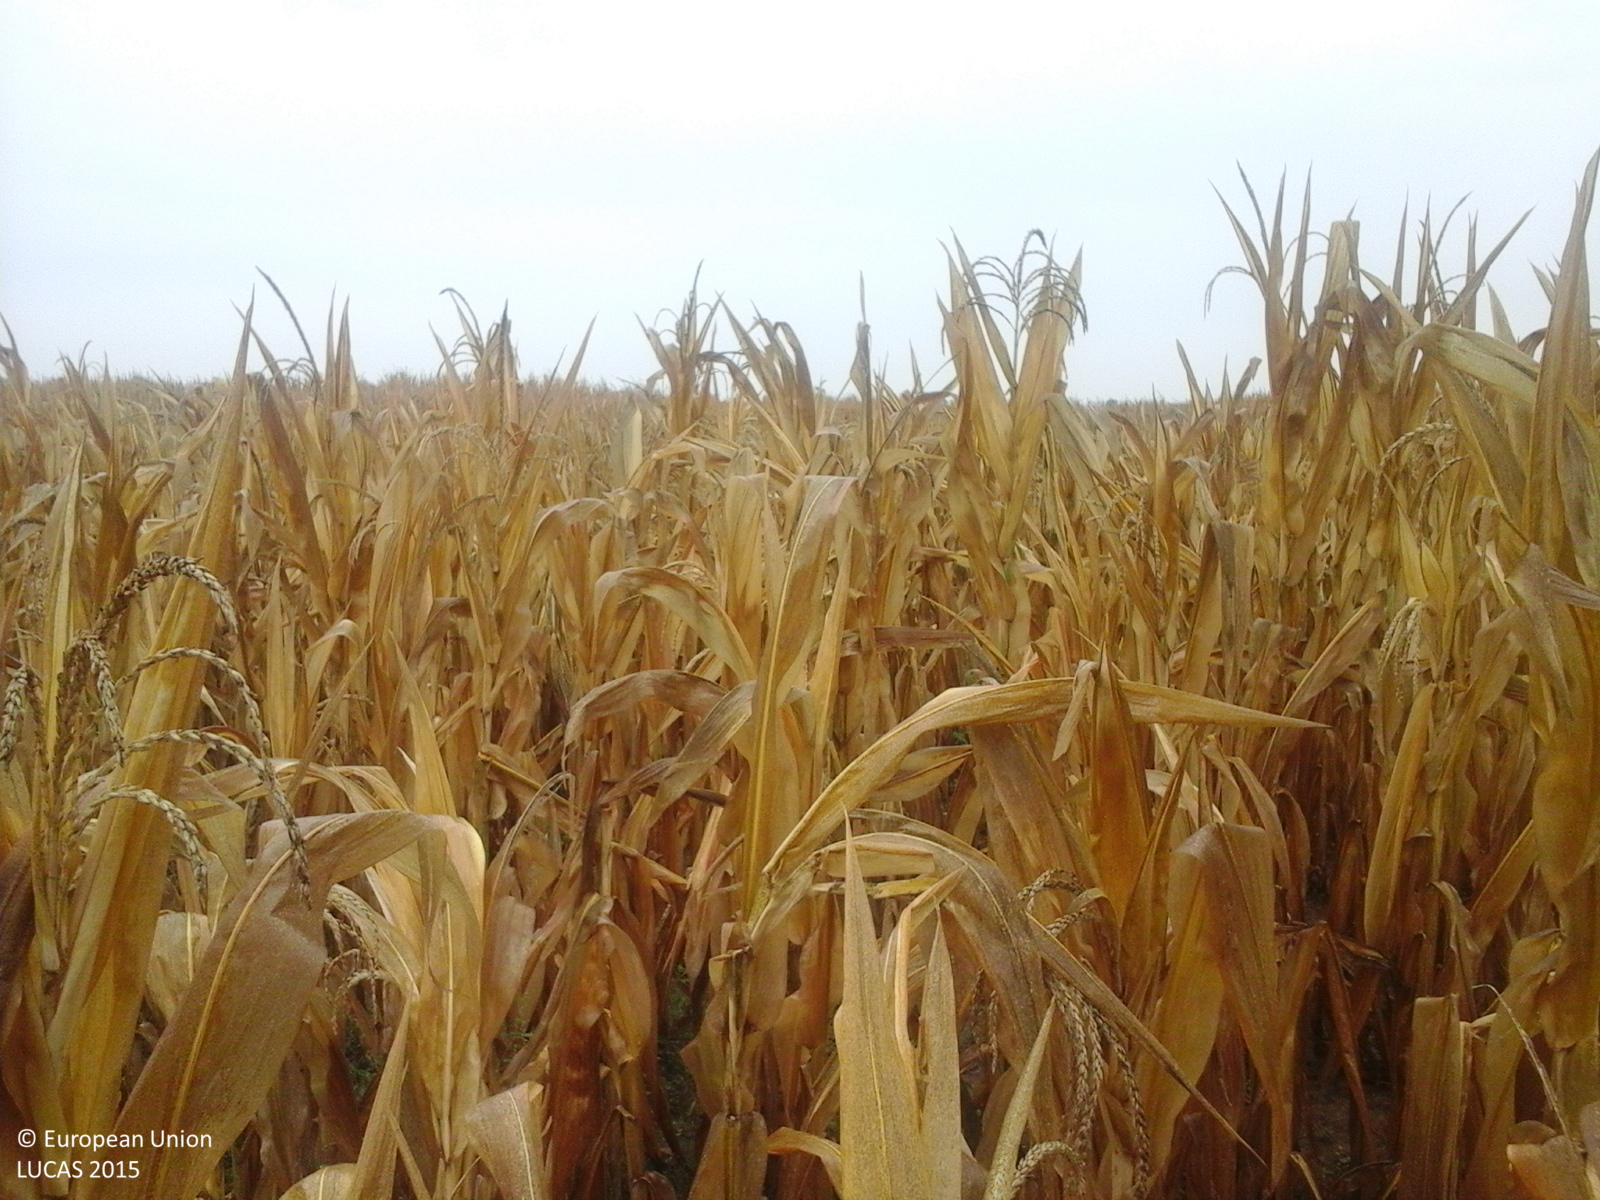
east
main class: Cropland
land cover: Maize
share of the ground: > 75 %
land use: Agriculture (excluding fallow land and kitchen gardens)
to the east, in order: Maize
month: September
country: RO
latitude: 47.5884
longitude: 22.5985
